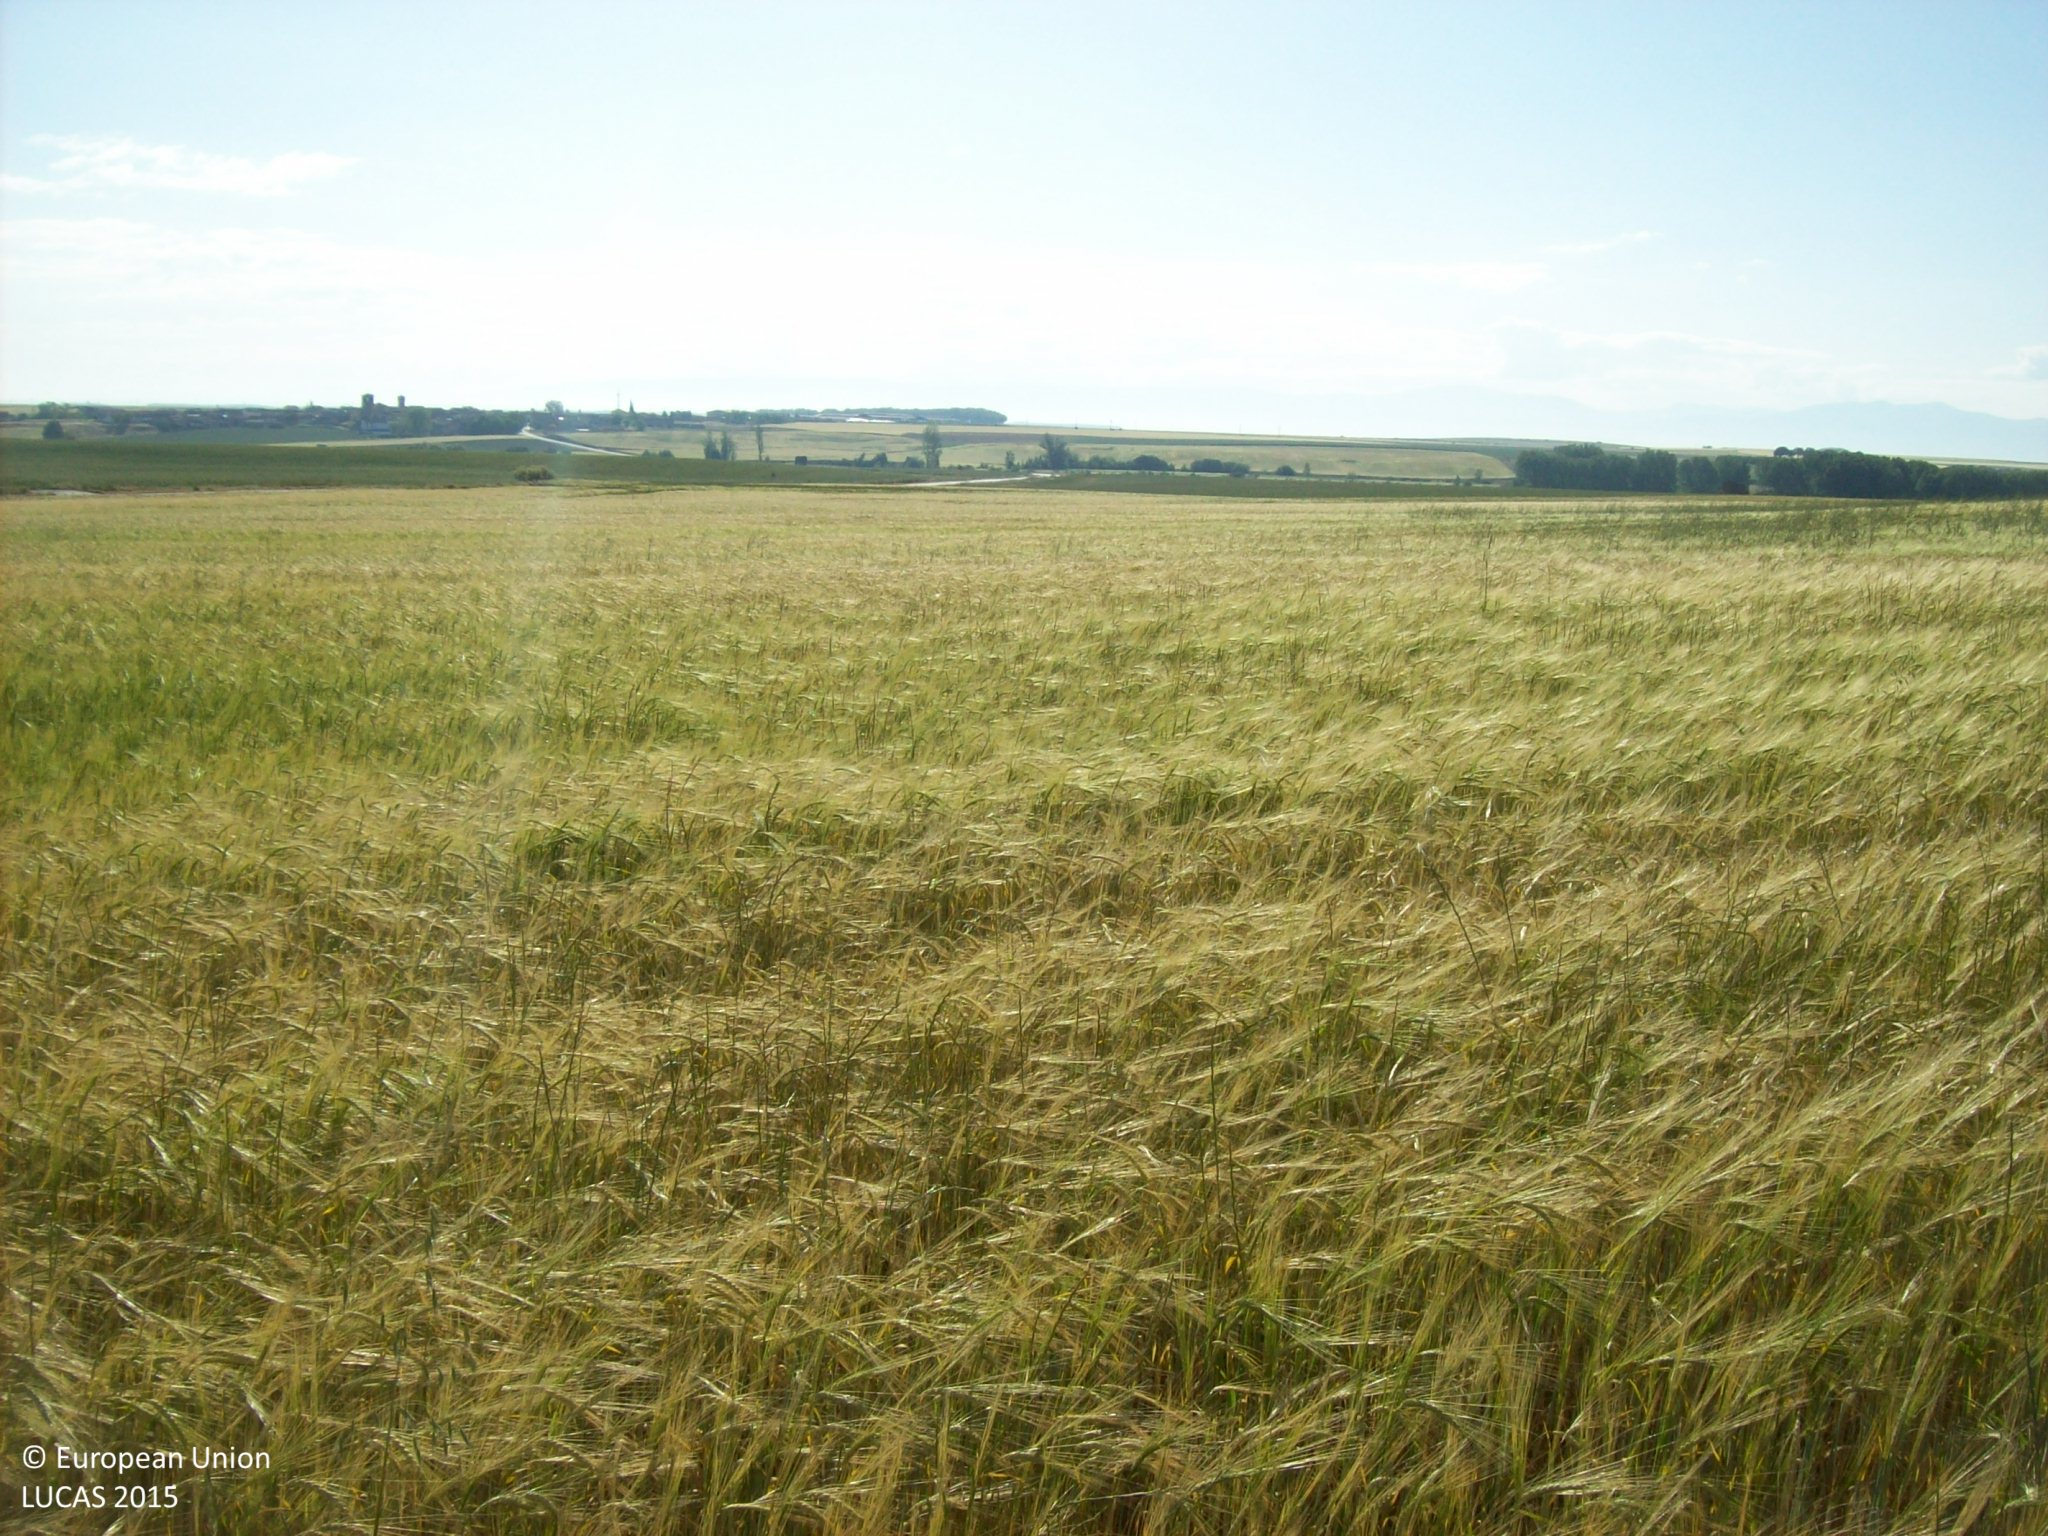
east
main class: Cropland
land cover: Barley
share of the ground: > 75 %
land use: Agriculture (excluding fallow land and kitchen gardens)
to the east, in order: Barley; Grass margins; Barley
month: May
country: ES
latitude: 40.9428
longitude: -4.5121
